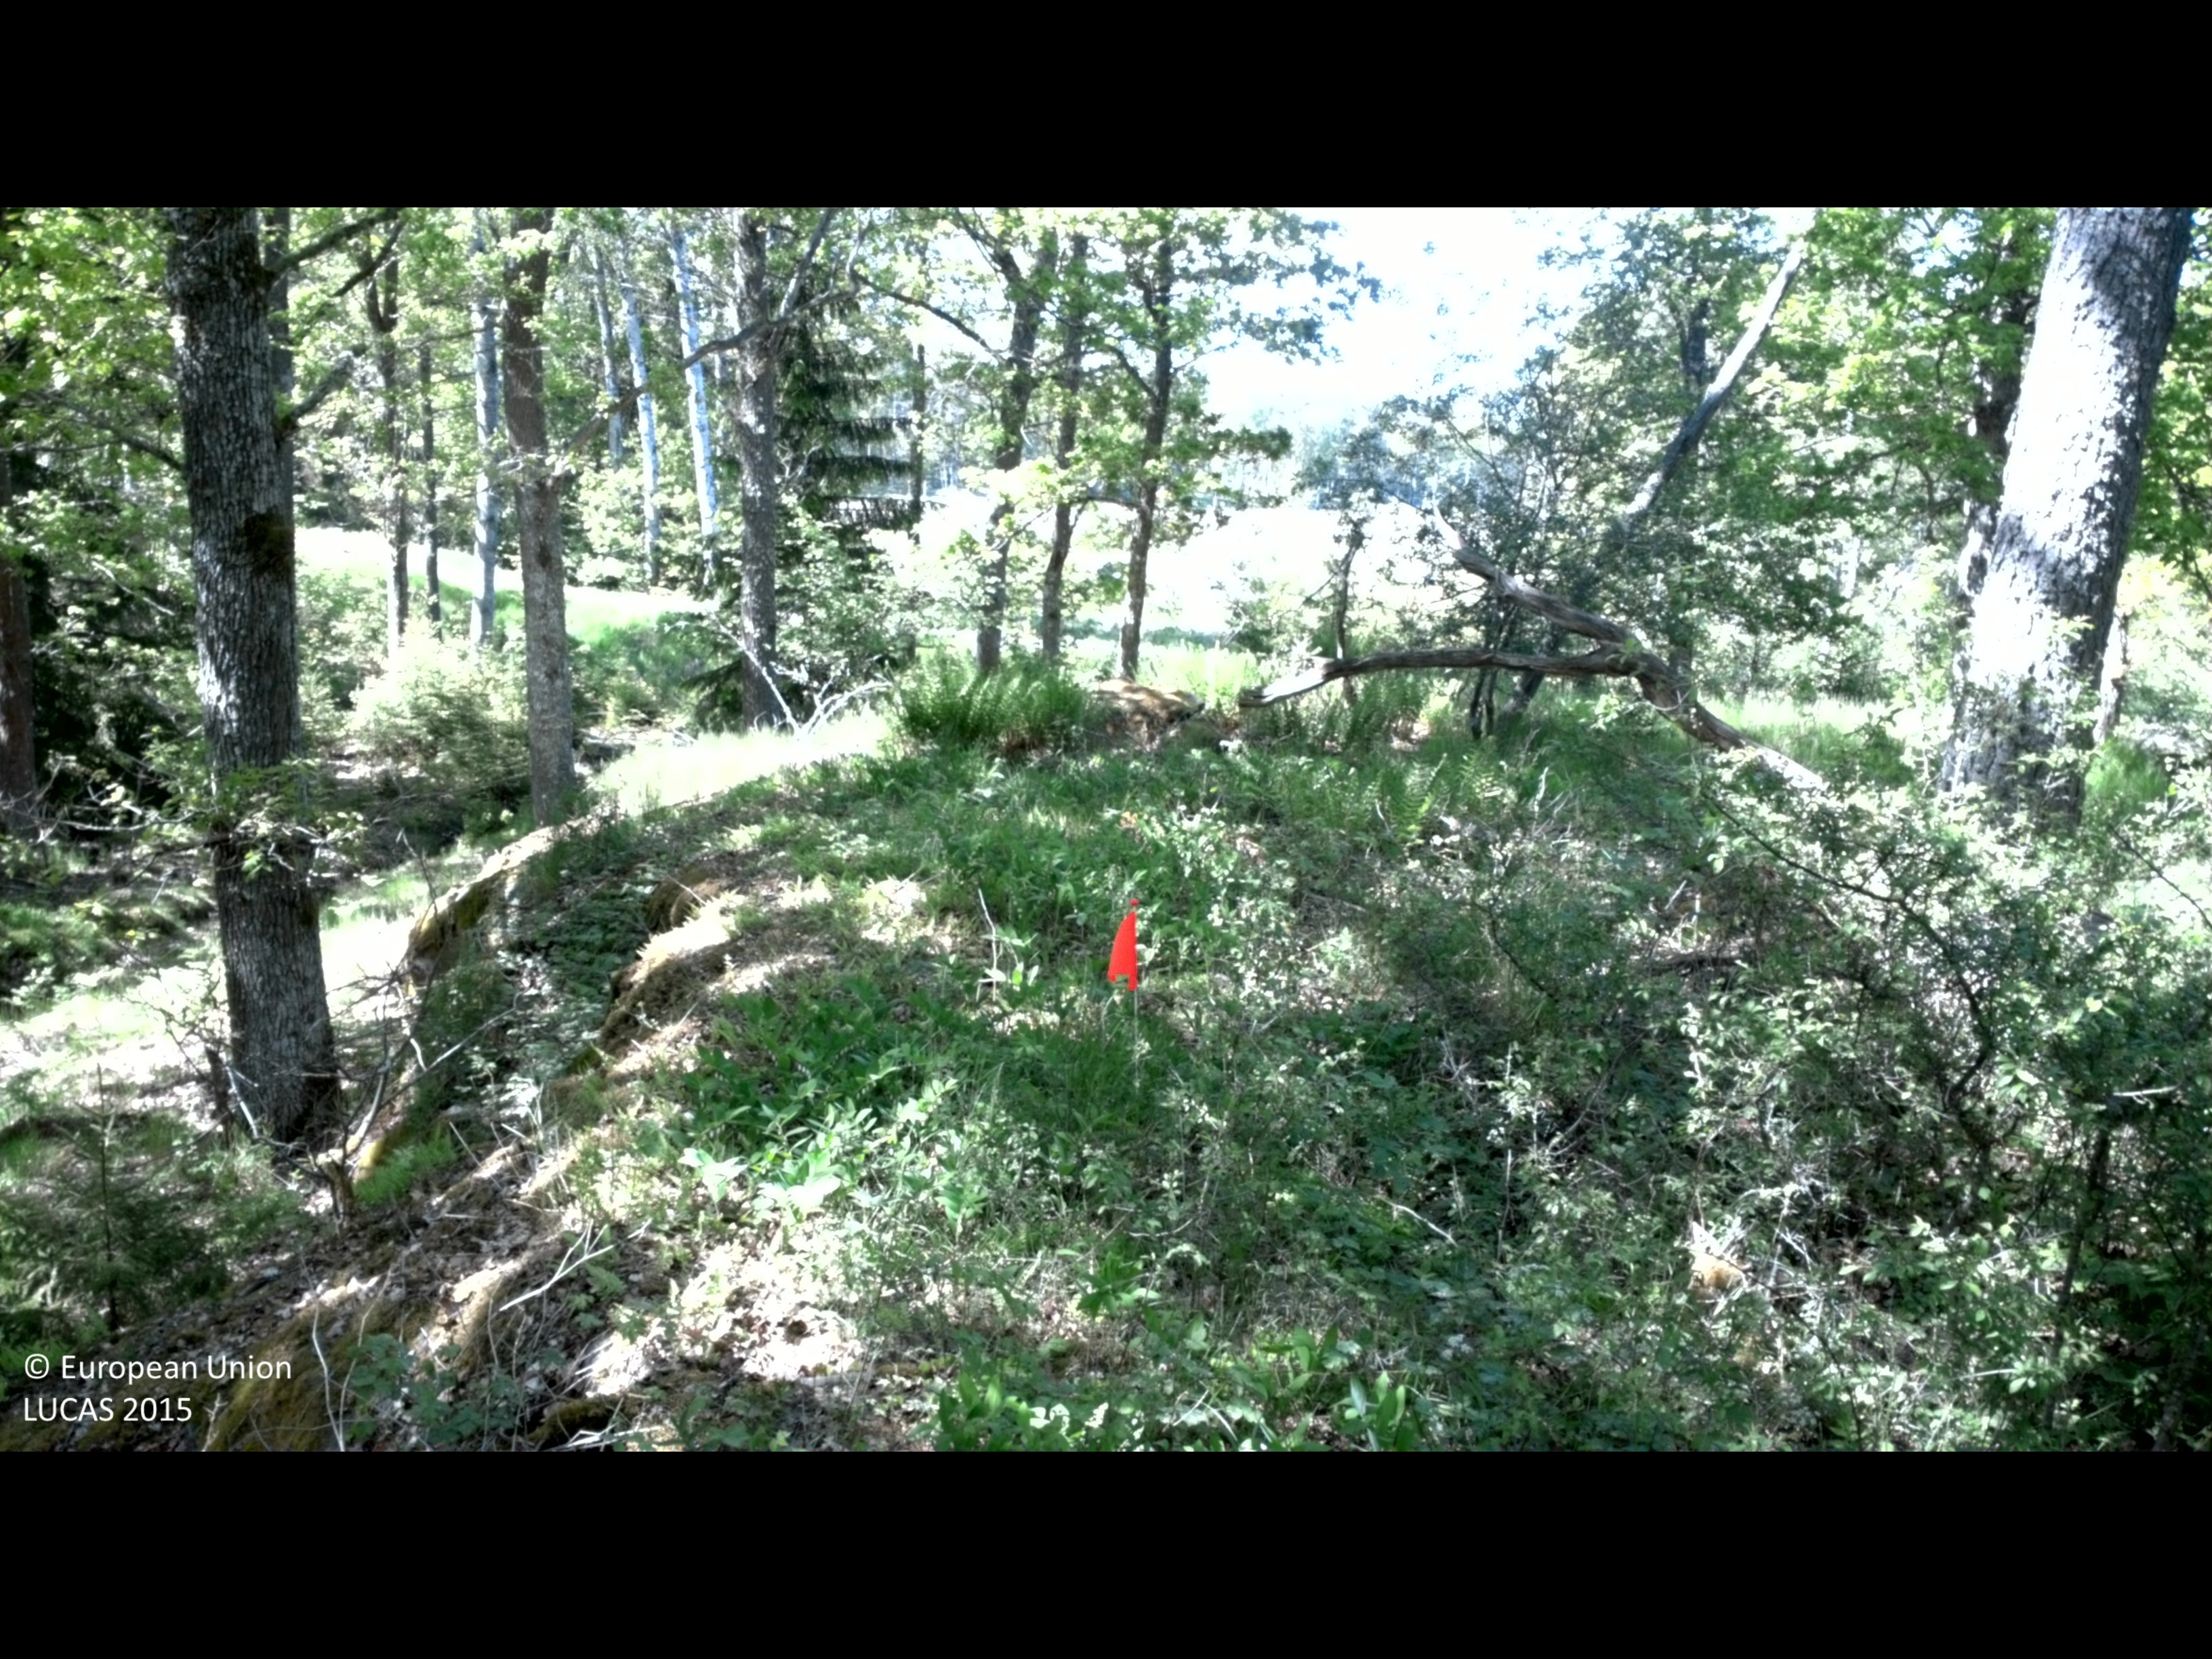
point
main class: Woodland
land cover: Broadleaved woodland
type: hemiboreal forest and nemoral coniferous forest and mixed broadleaved-coniferous forest
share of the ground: > 75 %
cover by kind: broadleaved forest trees 75 %, shrubs 10 %, herbaceous plants 10 %, coniferous forest trees 5 %
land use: Forestry
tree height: > 5 m
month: May
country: SE
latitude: 57.5535
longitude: 16.5669
